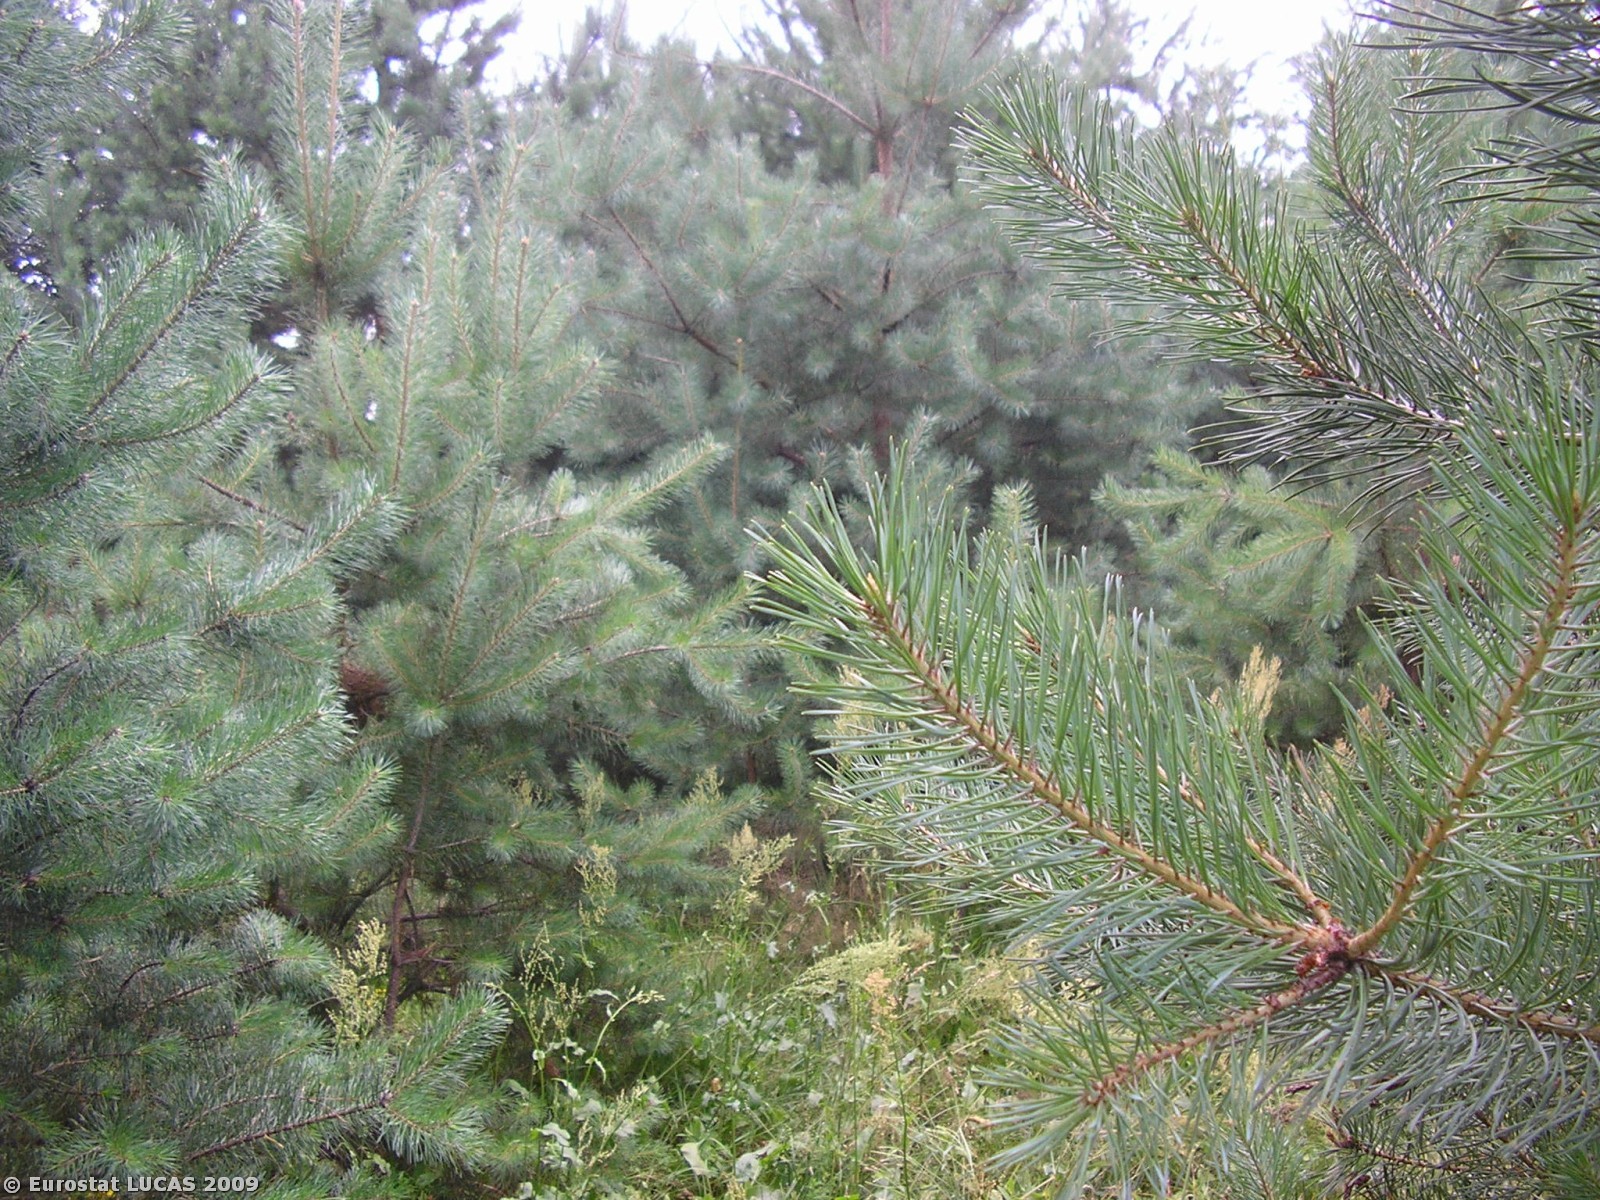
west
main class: Woodland
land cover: Coniferous woodland
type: hemiboreal forest and nemoral coniferous forest and mixed broadleaved-coniferous forest
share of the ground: > 75 %
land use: Forestry
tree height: > 5 m
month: July
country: PL
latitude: 51.4865
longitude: 21.5294
